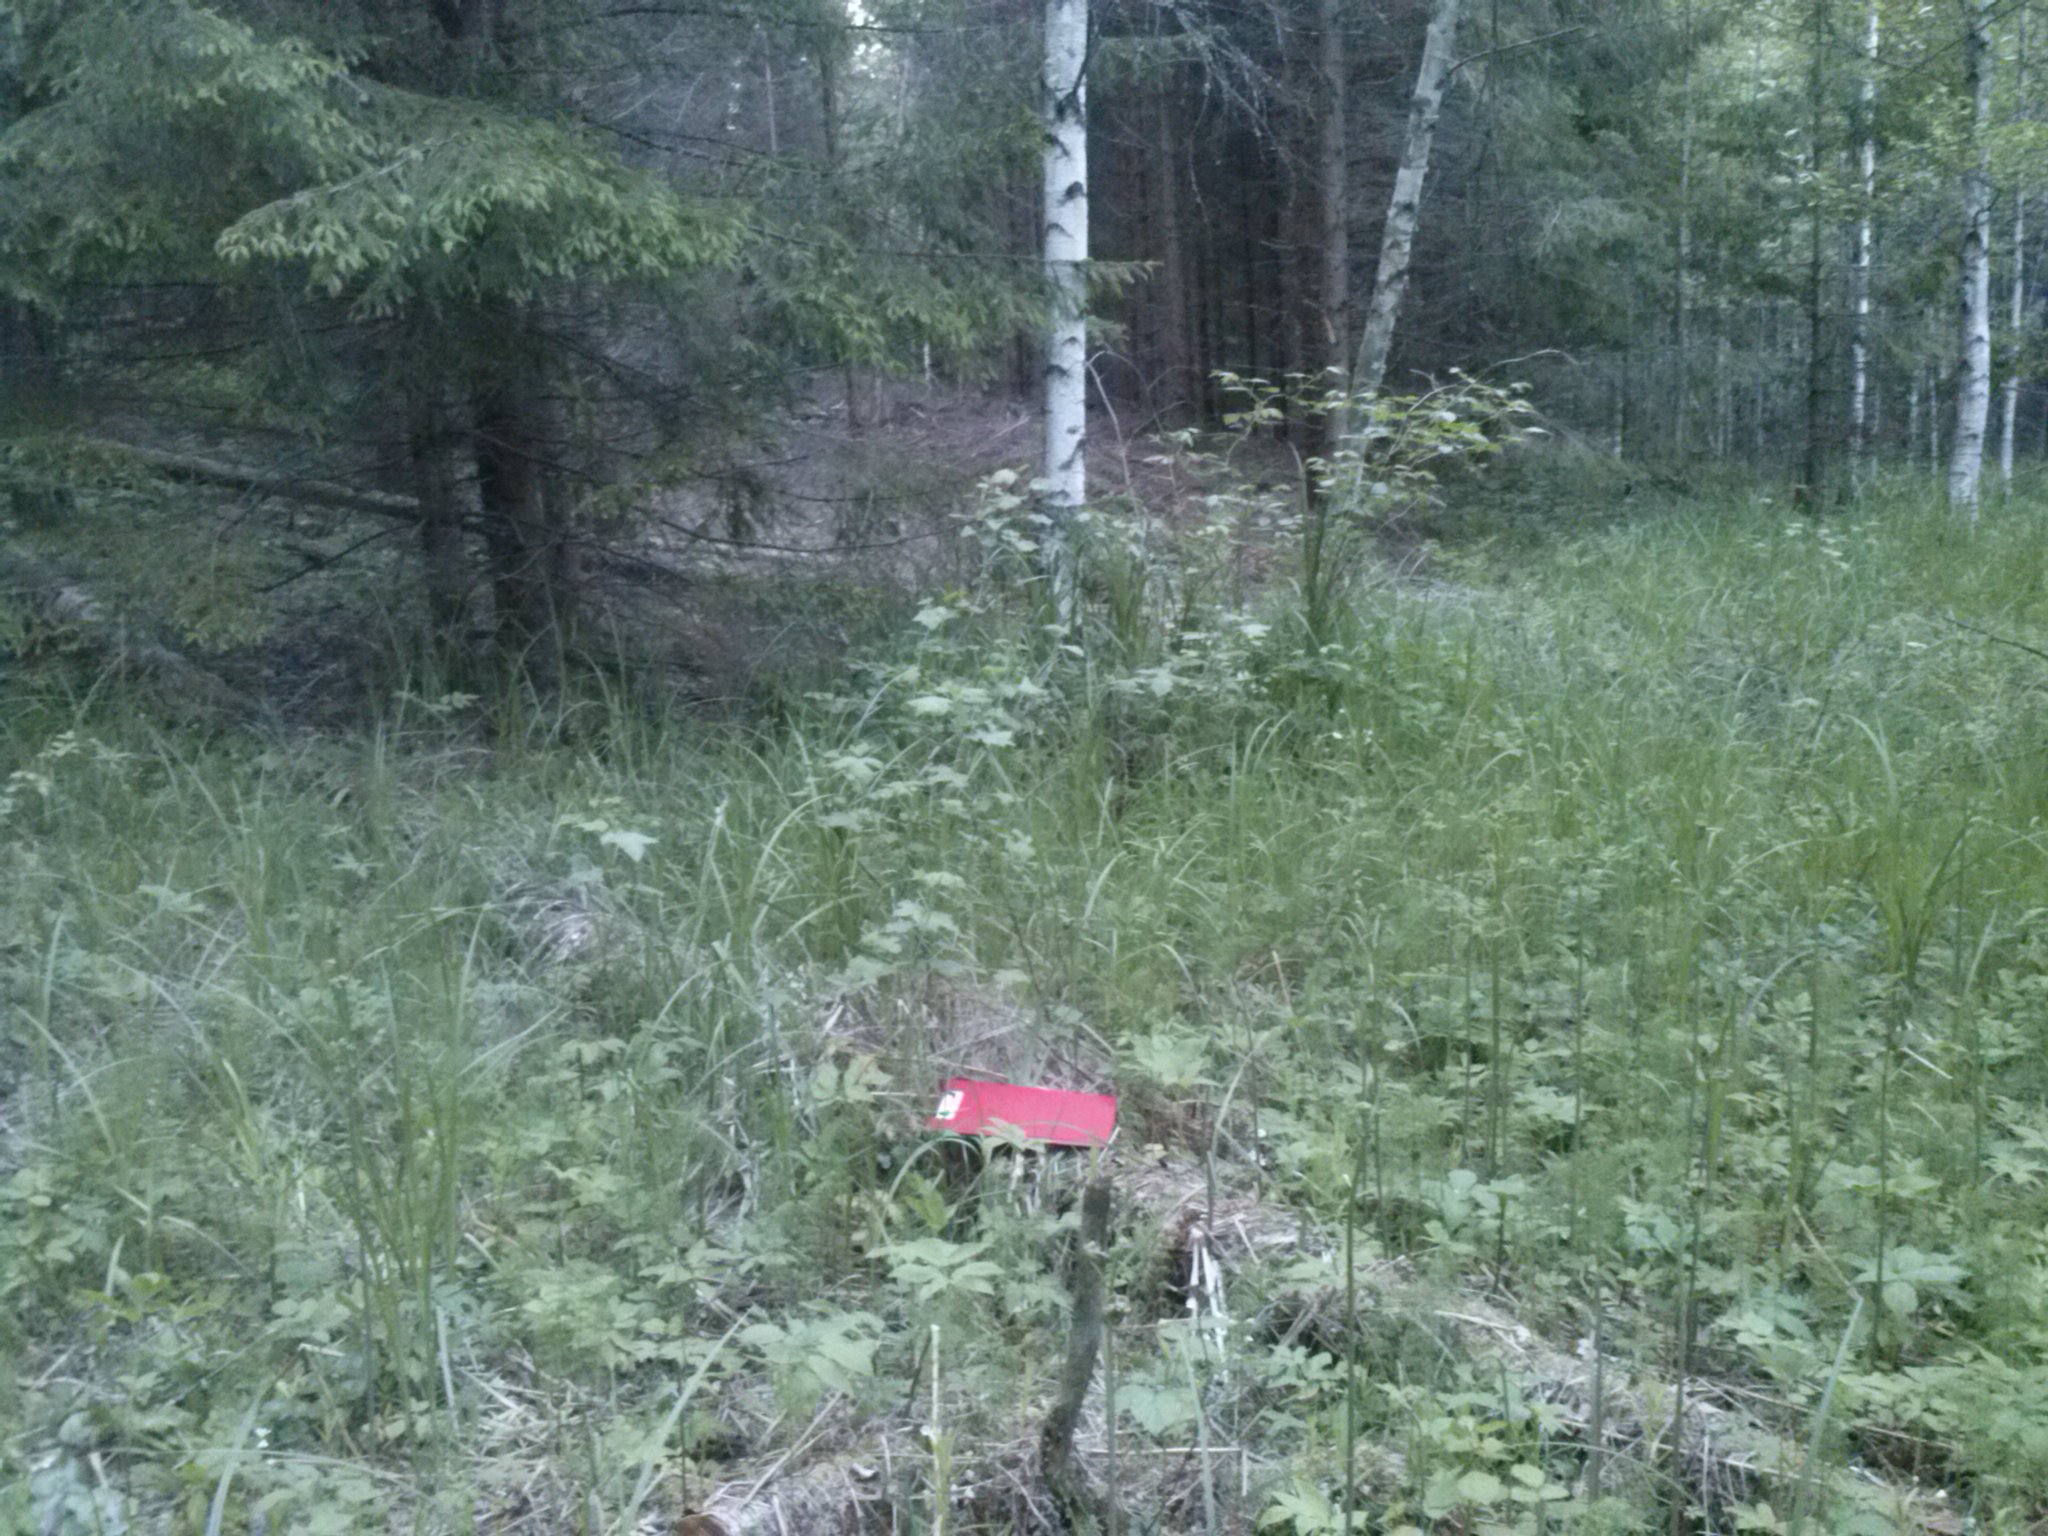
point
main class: Woodland
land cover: Spruce dominated mixed woodland
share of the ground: 50 - 75 %
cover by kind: coniferous forest trees 35 %, herbaceous plants 30 %, broadleaved forest trees 25 %, shrubs 10 %
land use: Forestry
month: May
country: LV
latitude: 56.3612
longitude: 27.8511
